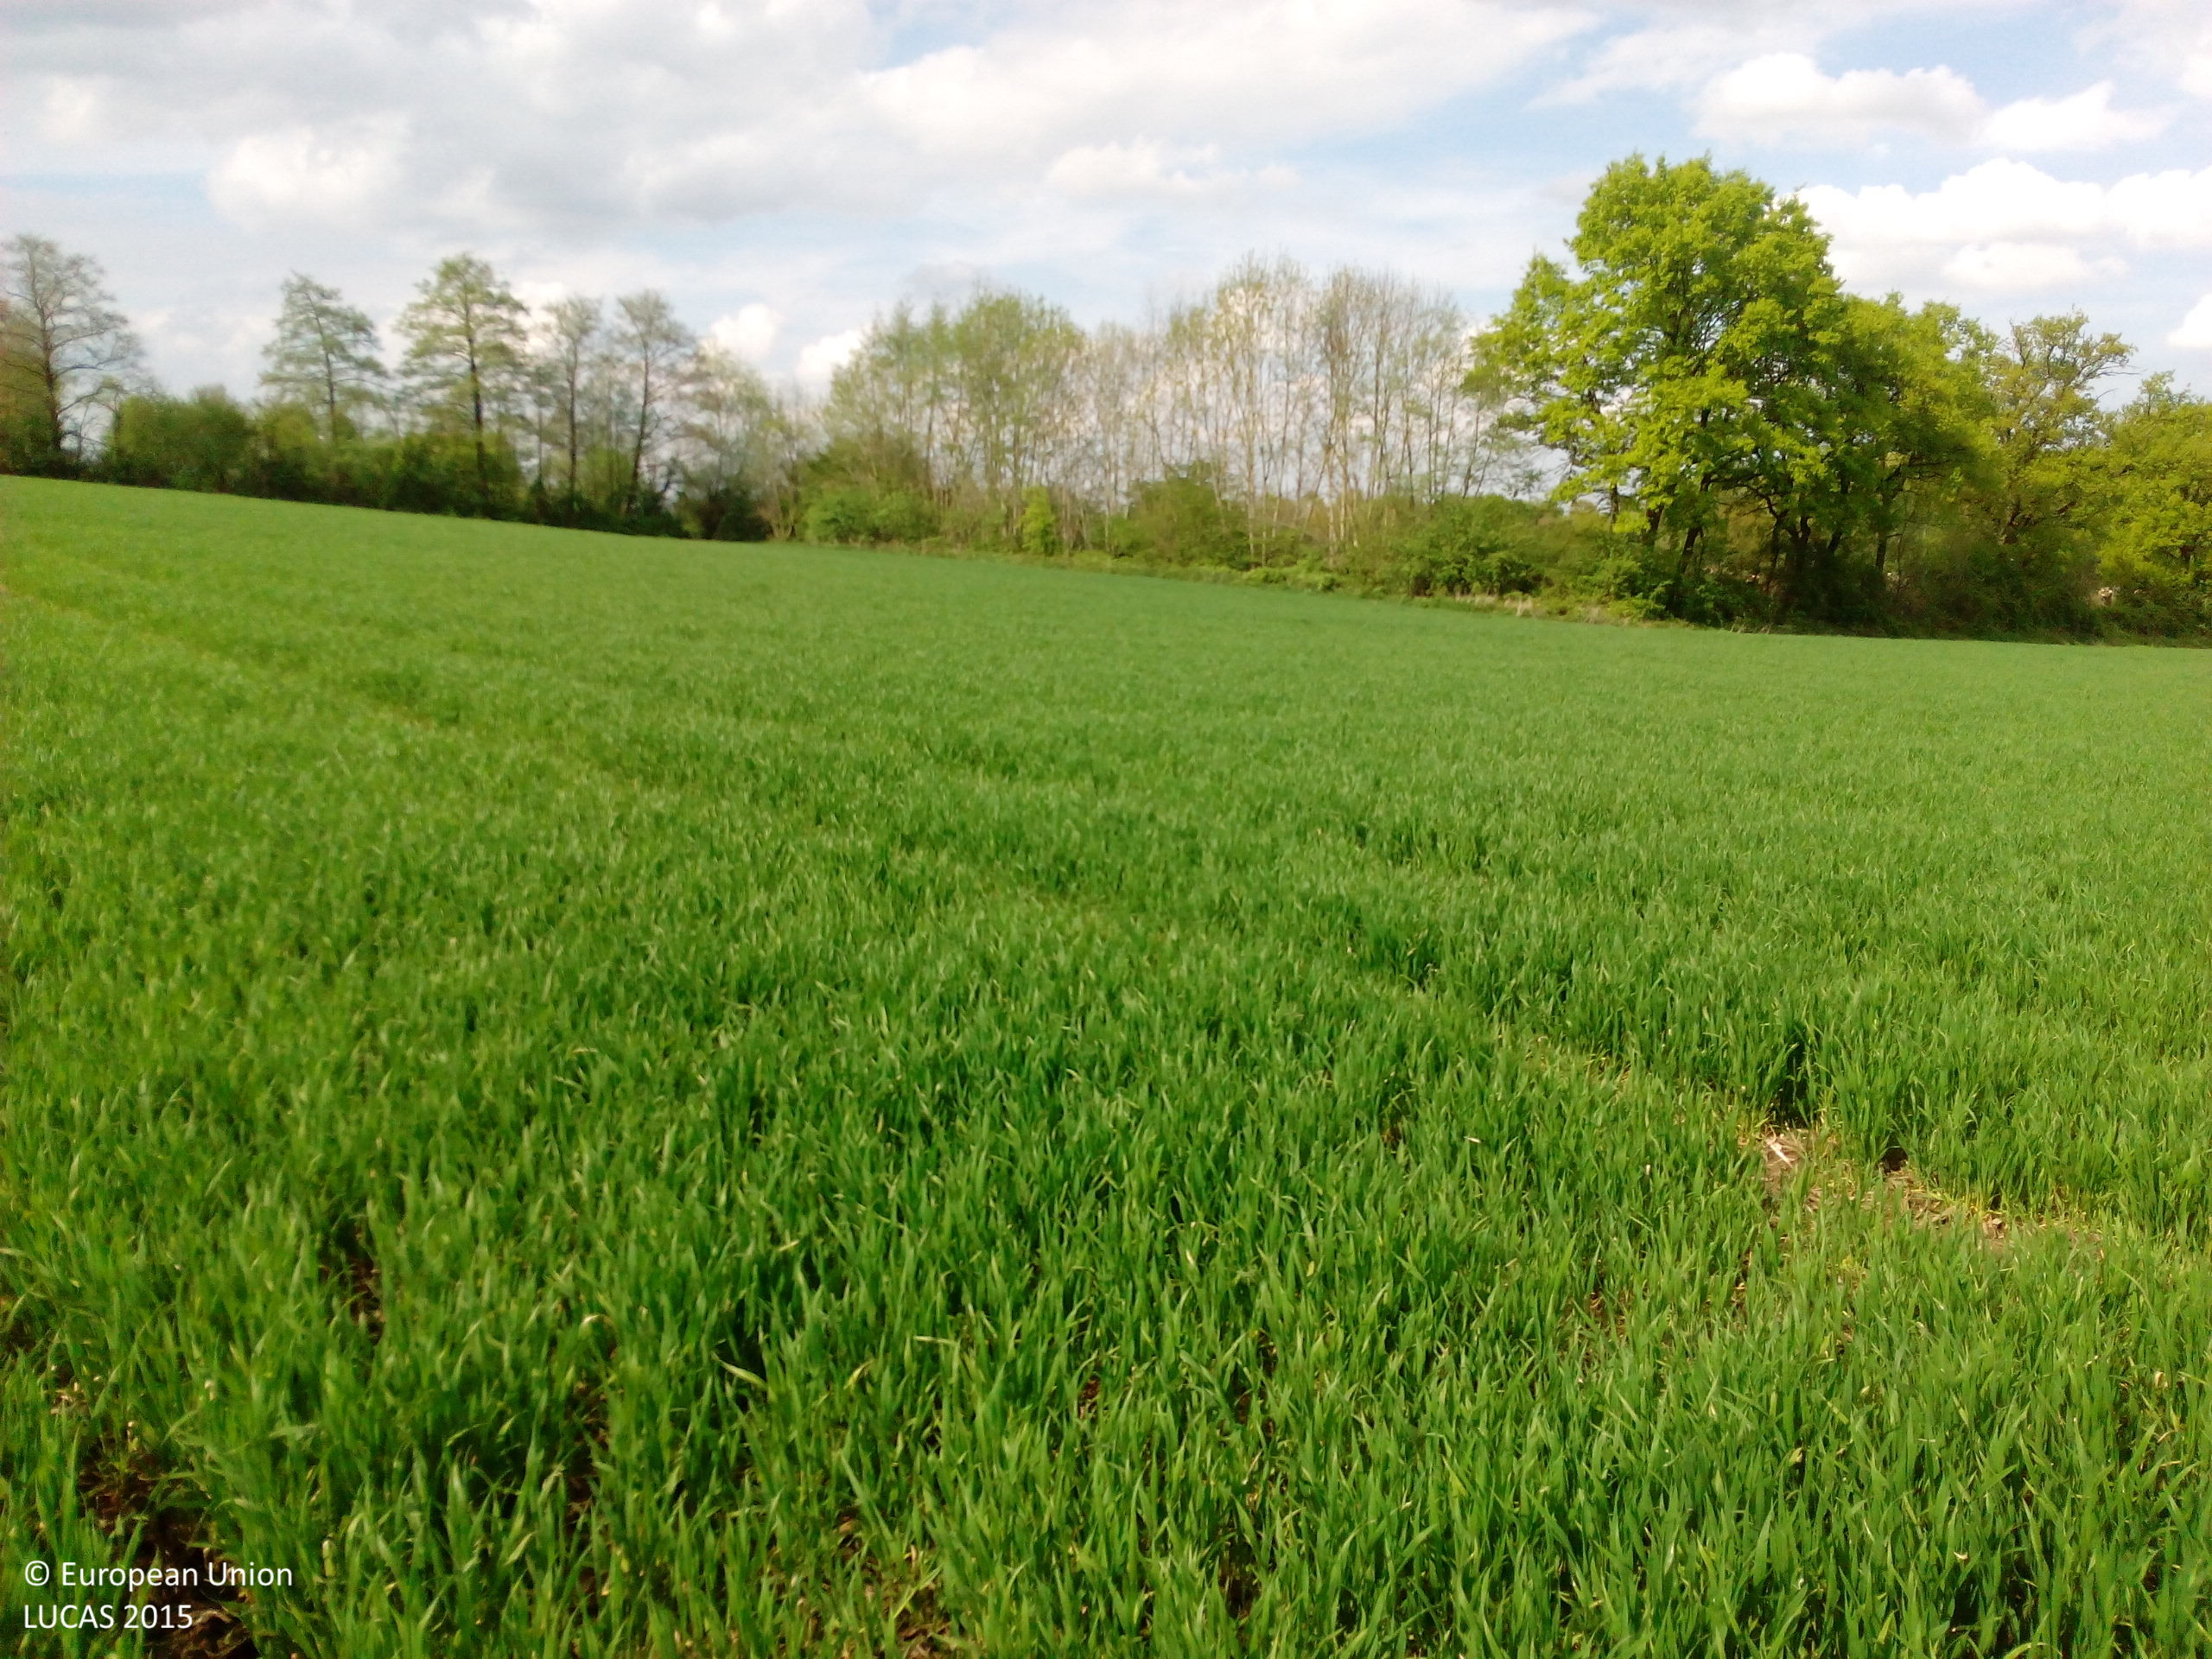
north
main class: Cropland
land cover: Common wheat
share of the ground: 50 - 75 %
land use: Agriculture (excluding fallow land and kitchen gardens)
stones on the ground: < 10 %
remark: Tilled/Sowed
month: May
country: DE
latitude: 51.7557
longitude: 7.4071
